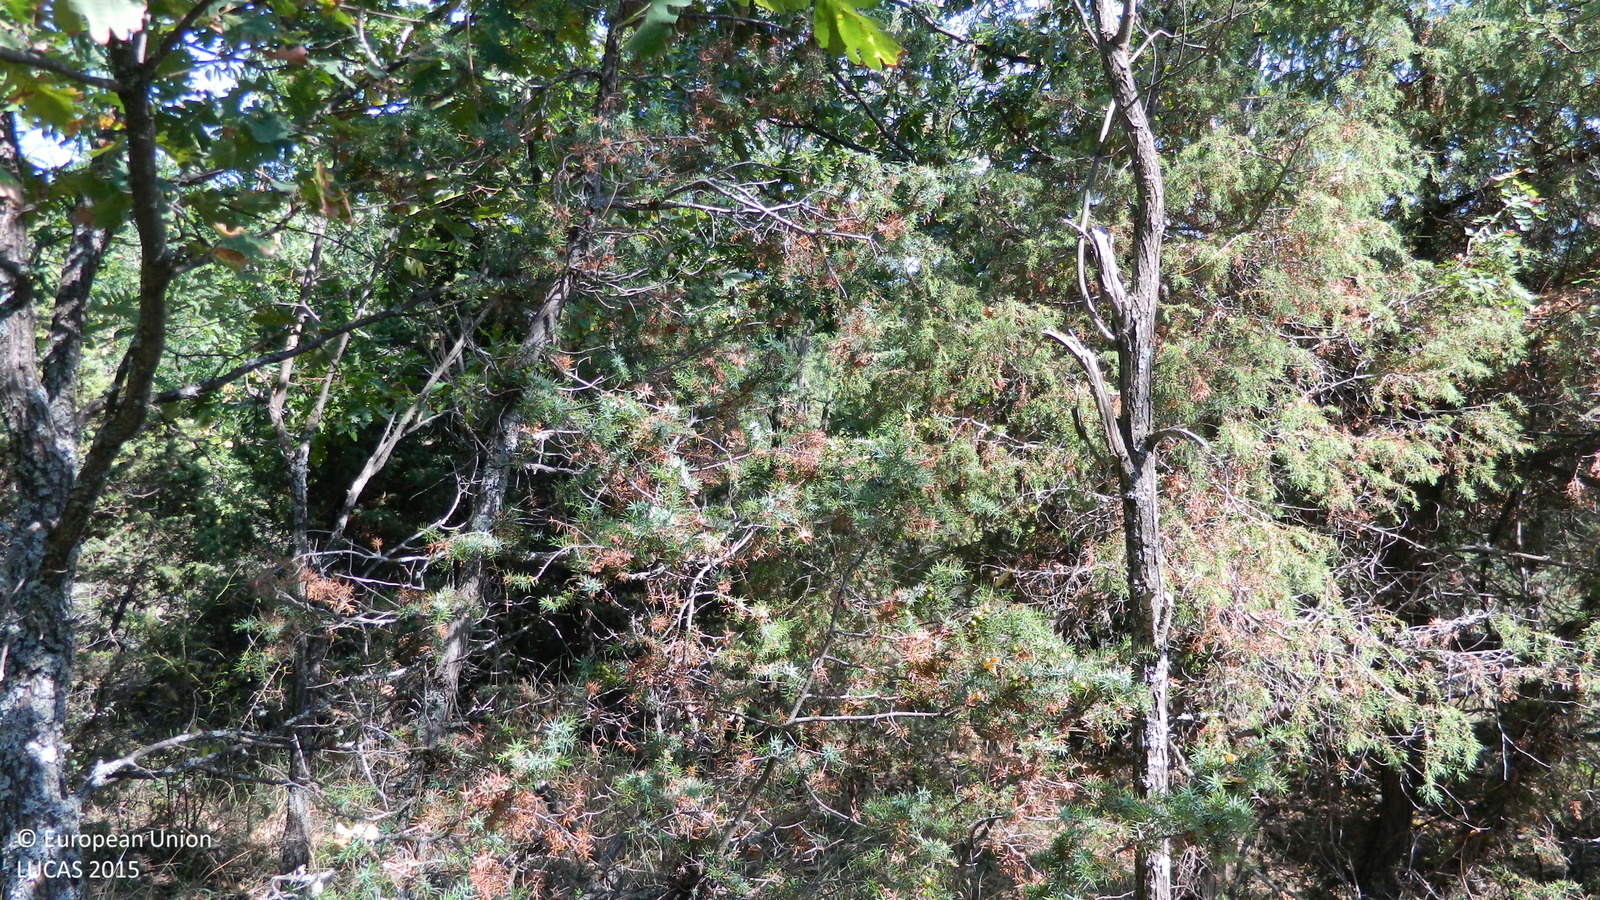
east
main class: Woodland
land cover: Other mixed woodland
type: coniferous forest of the mediterranean region
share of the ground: > 75 %
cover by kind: coniferous forest trees 50 %, broadleaved forest trees 50 %
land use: Forestry
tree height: > 5 m
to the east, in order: Other mixed woodland
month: August
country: BG
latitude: 41.5281
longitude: 25.9467
